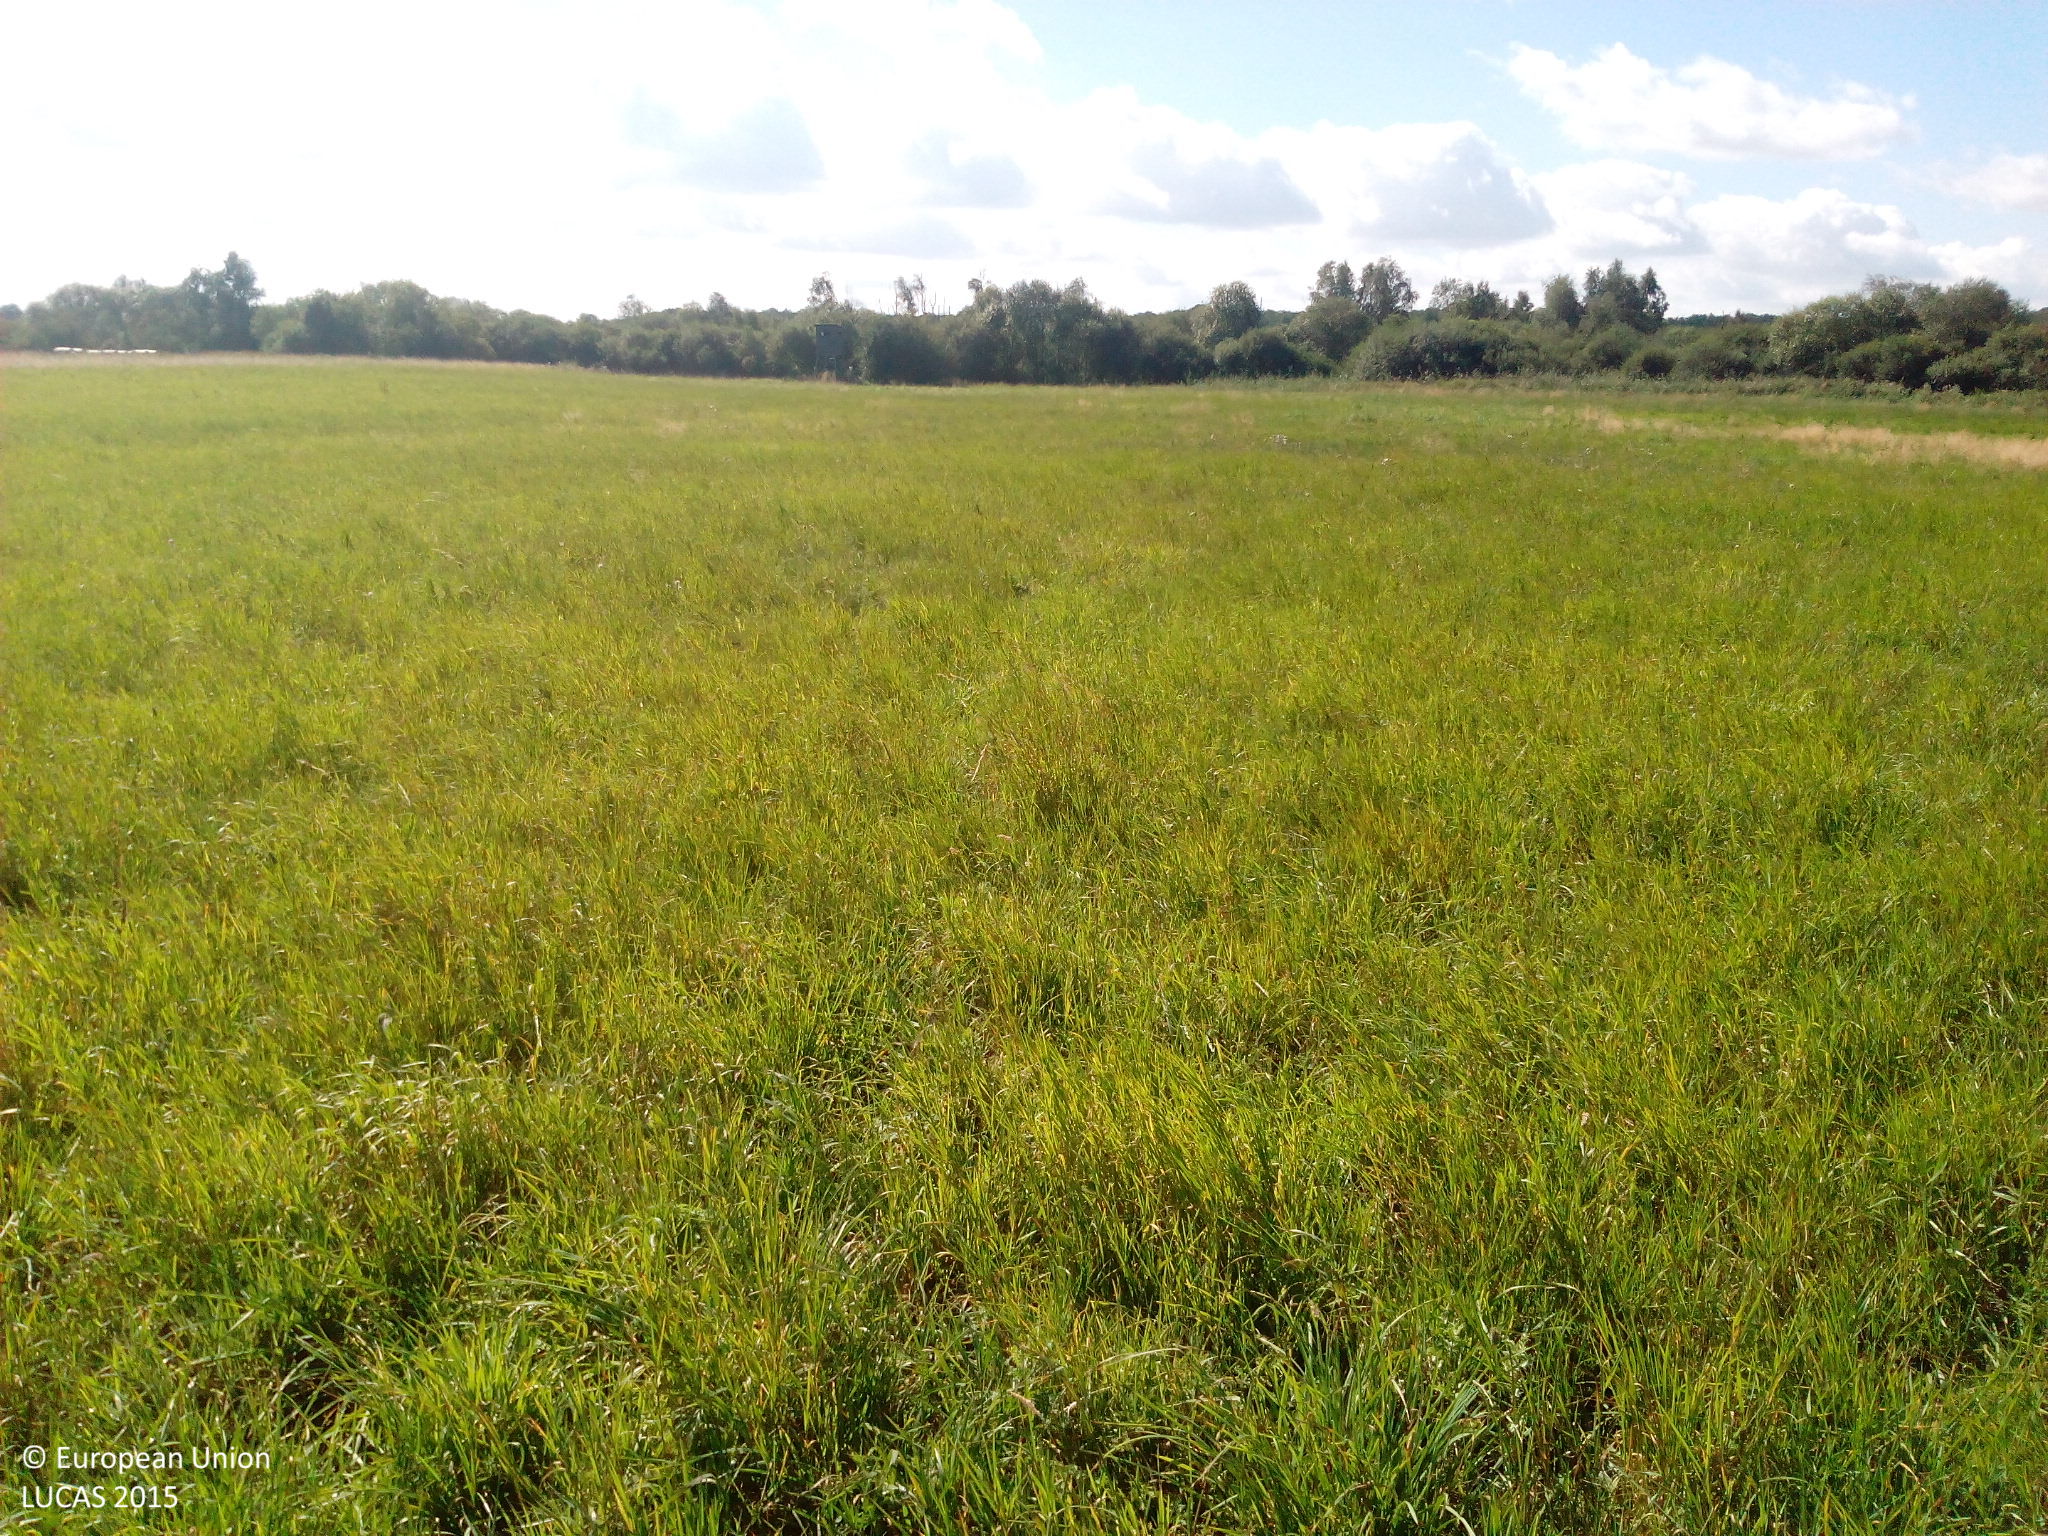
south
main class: Grassland
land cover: Grassland without tree/shrub cover
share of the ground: > 75 %
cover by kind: herbaceous plants 100 %
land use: Agriculture (excluding fallow land and kitchen gardens)
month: September
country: DE
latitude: 53.9908
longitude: 12.3327
